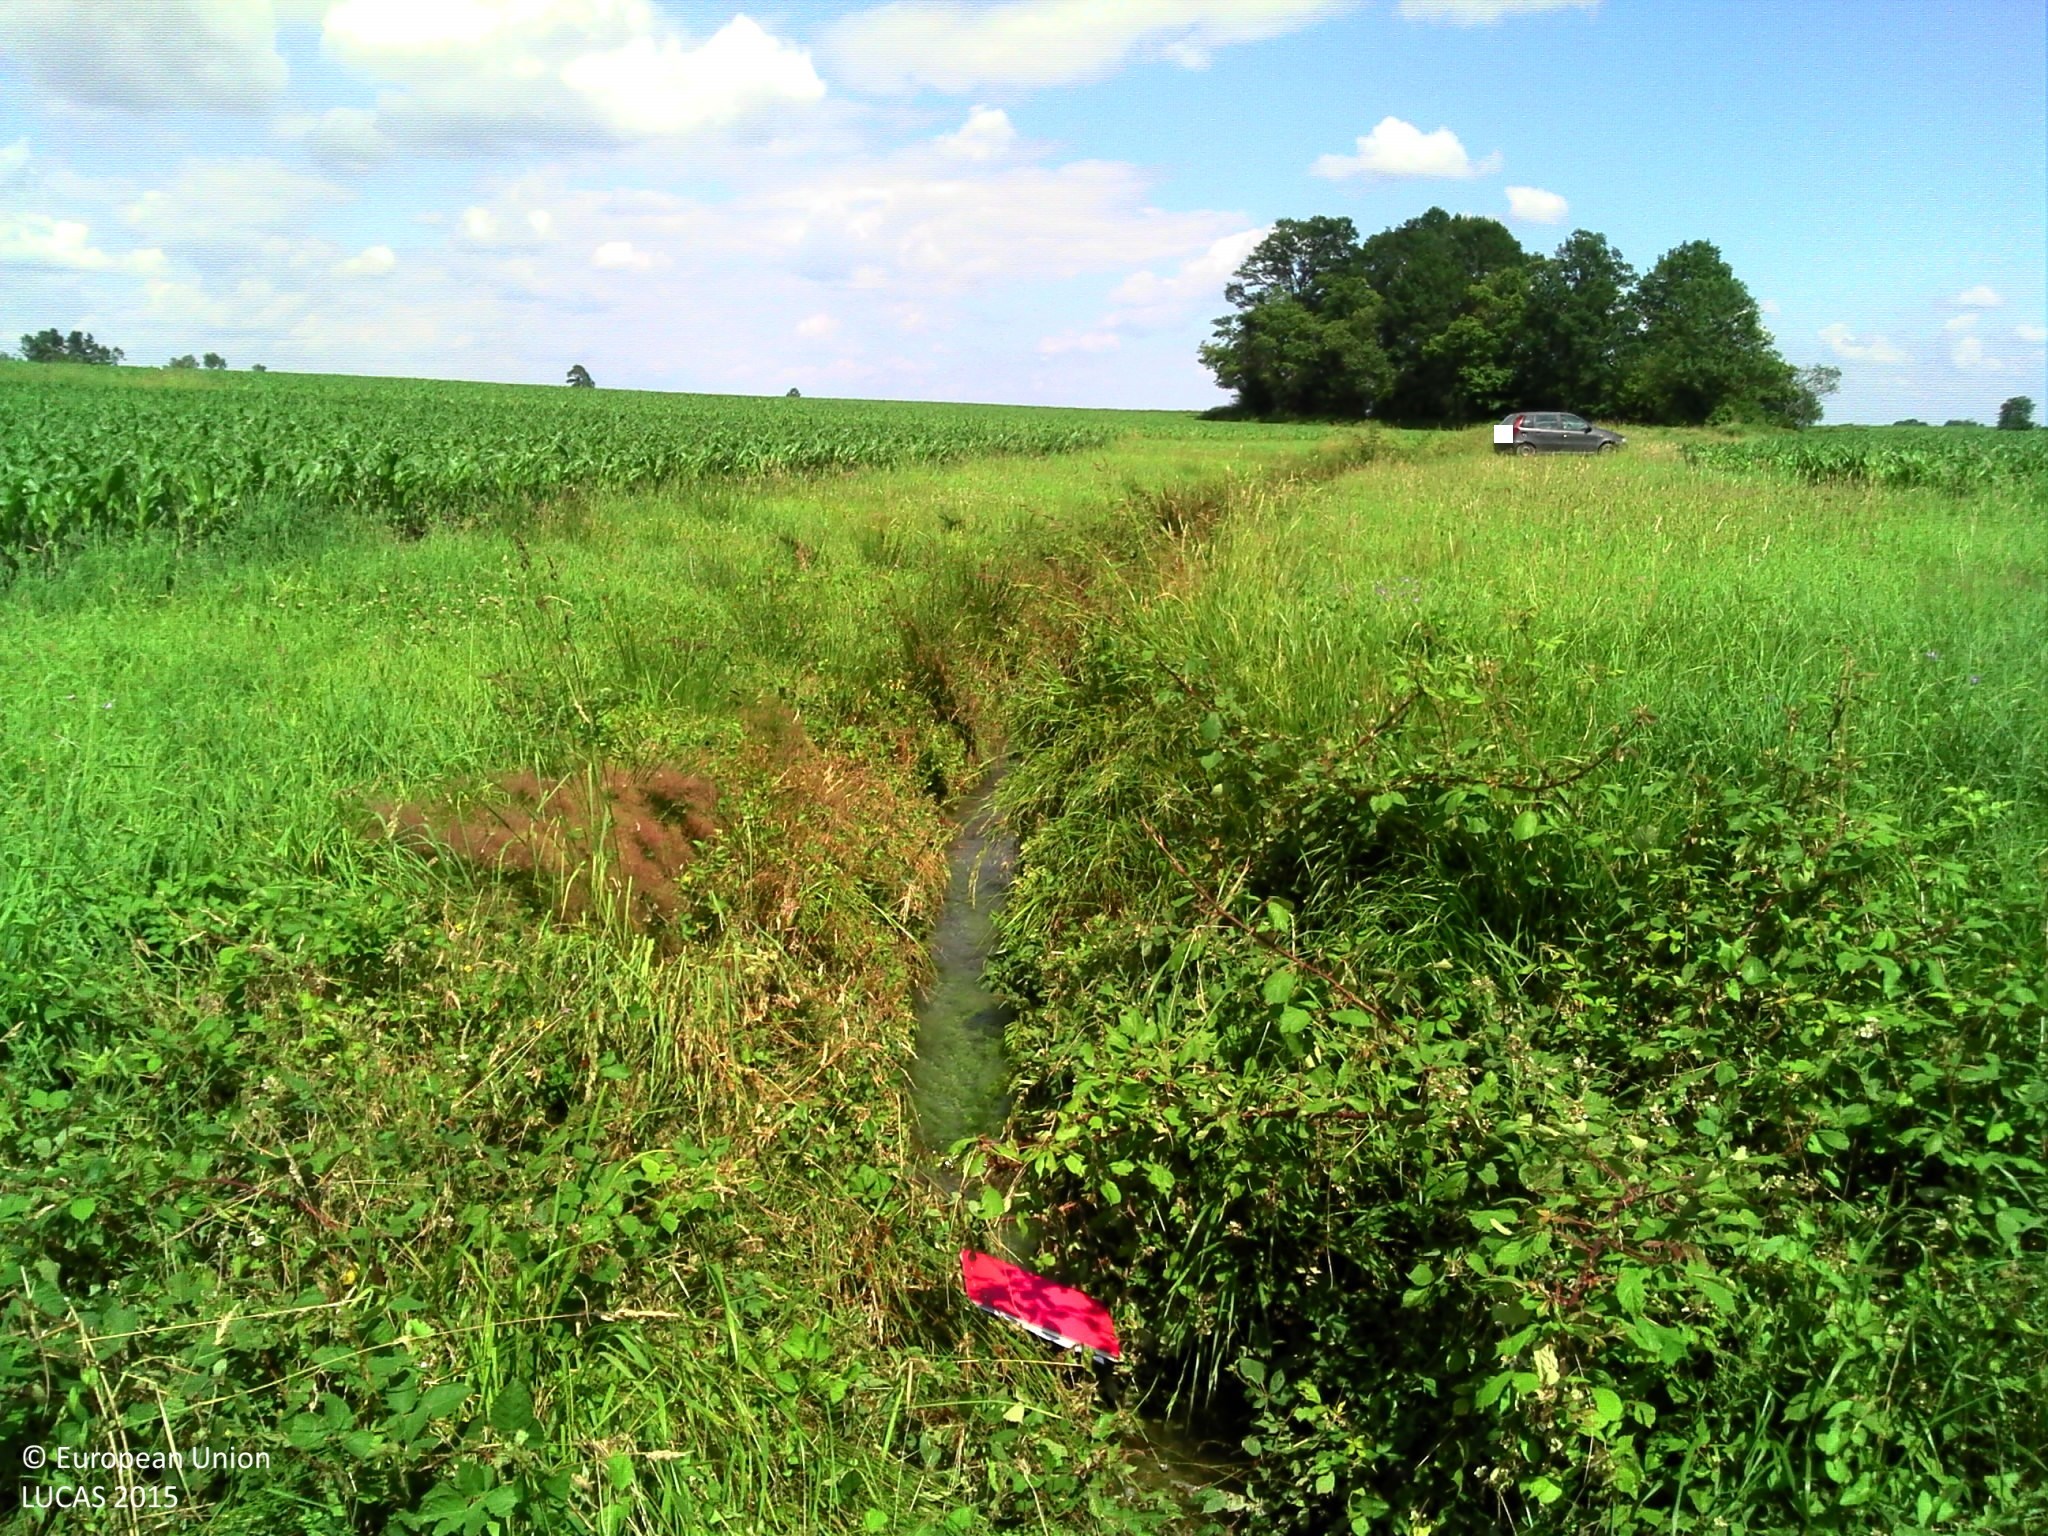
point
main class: Grassland
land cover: Grassland without tree/shrub cover
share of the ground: > 75 %
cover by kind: herbaceous plants 95 %, shrubs 5 %
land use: Agriculture (excluding fallow land and kitchen gardens)
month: June
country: FR
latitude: 43.2682
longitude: -0.1694
